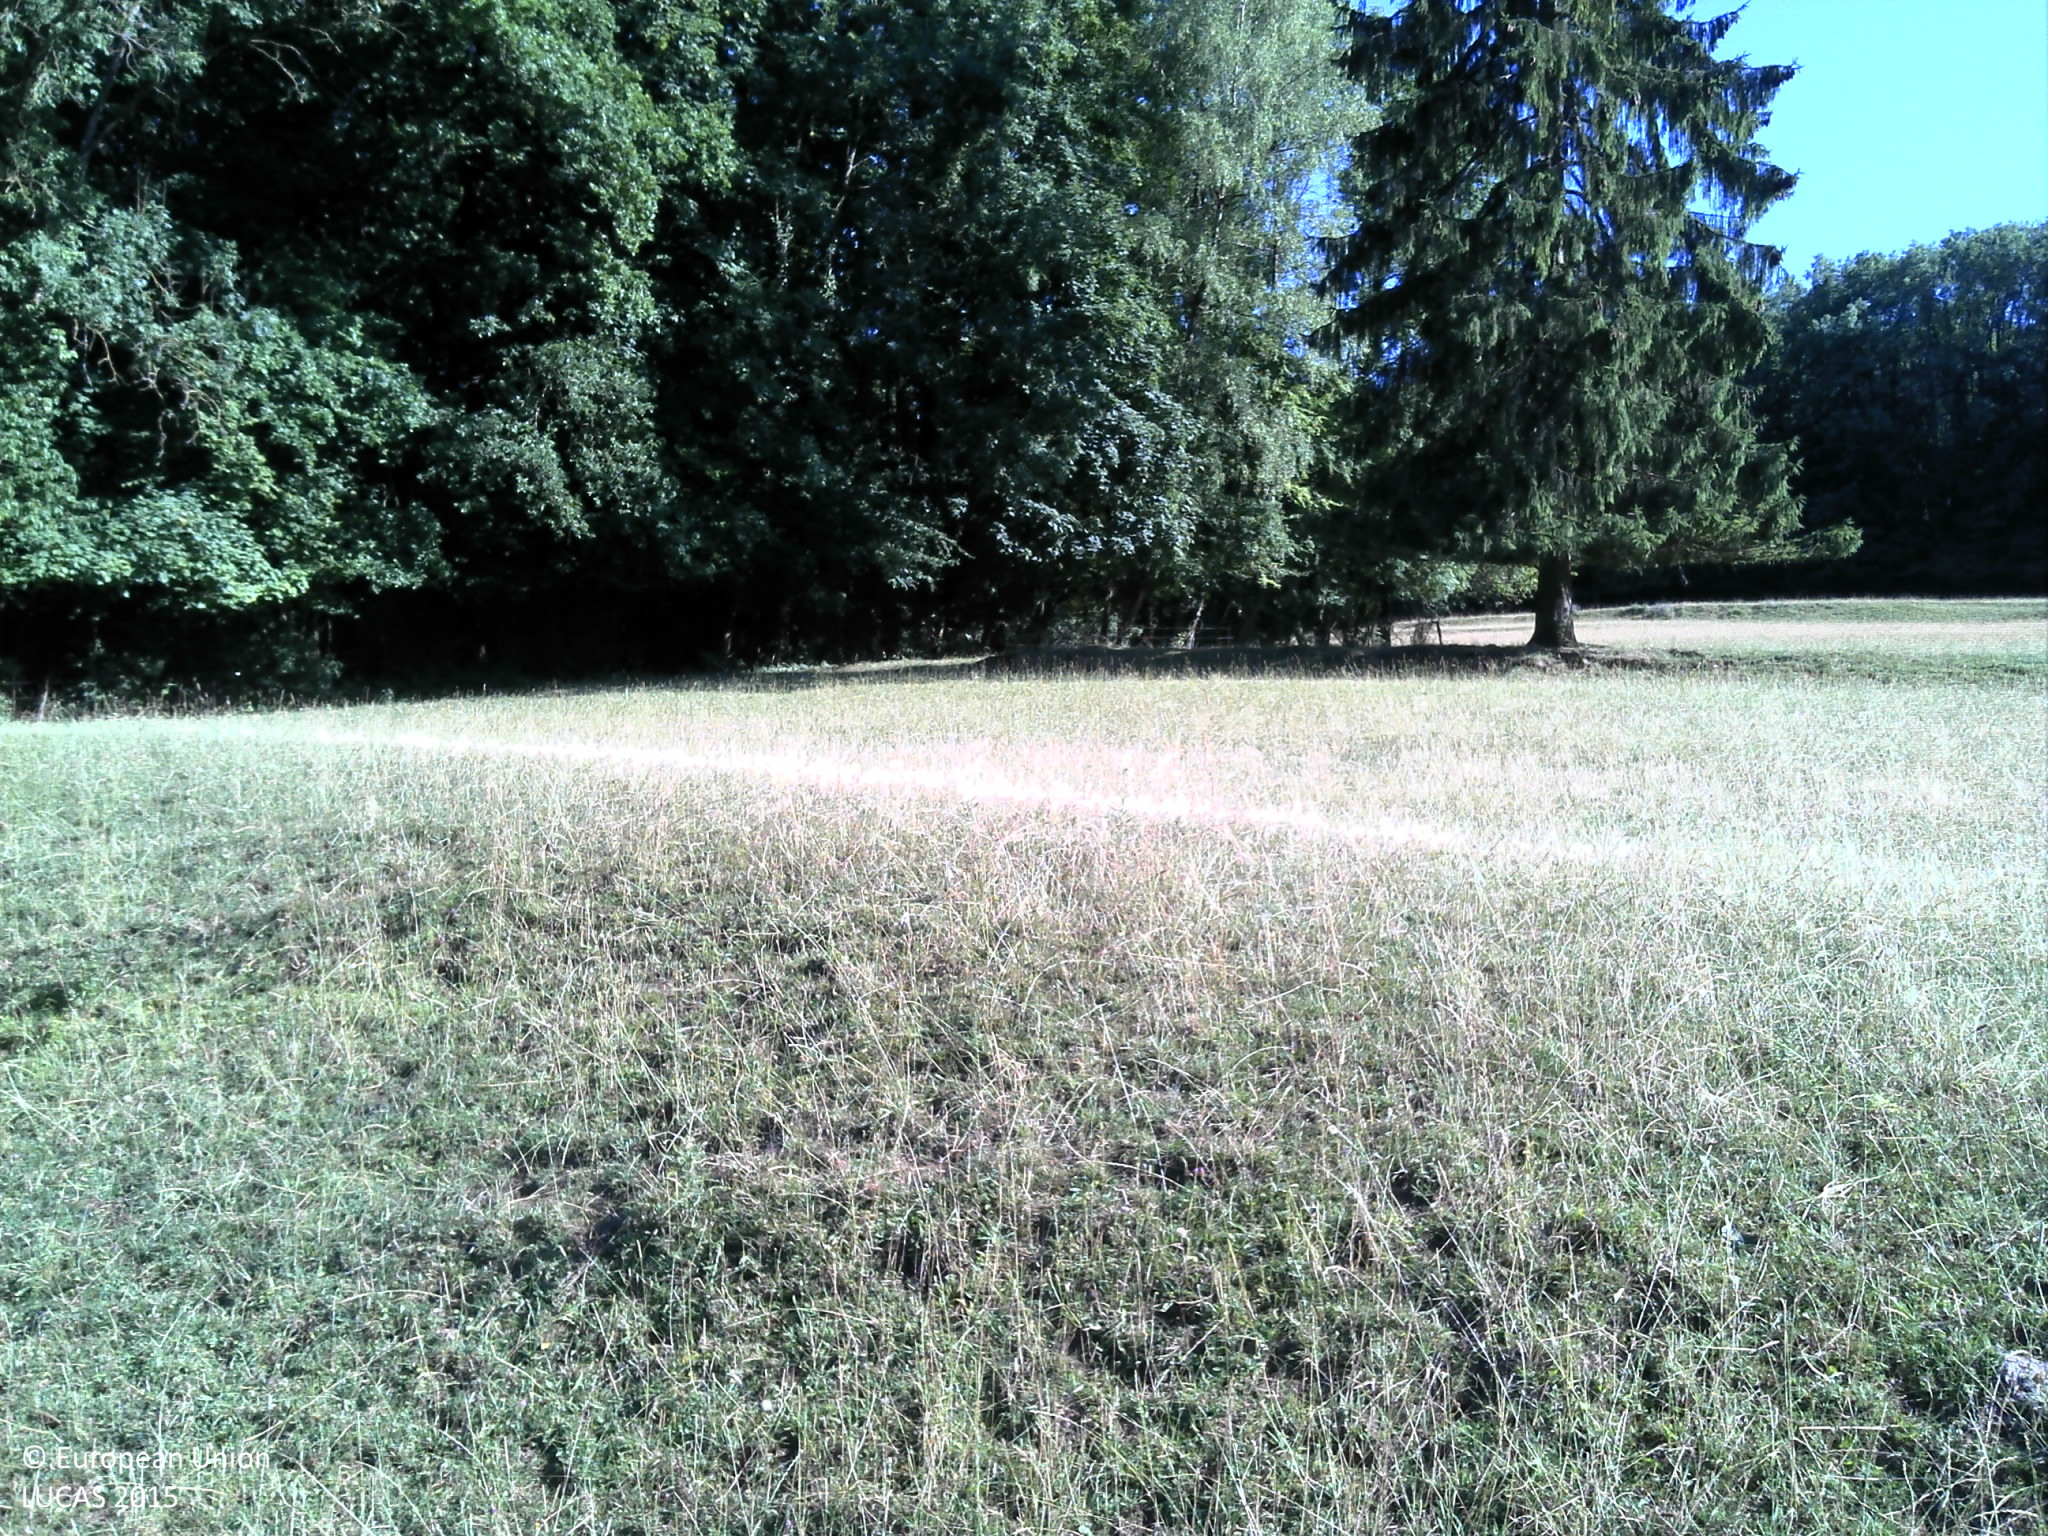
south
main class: Grassland
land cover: Grassland without tree/shrub cover
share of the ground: > 75 %
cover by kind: herbaceous plants 100 %
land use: Agriculture (excluding fallow land and kitchen gardens)
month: July
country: FR
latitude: 49.6846
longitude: 4.7437
